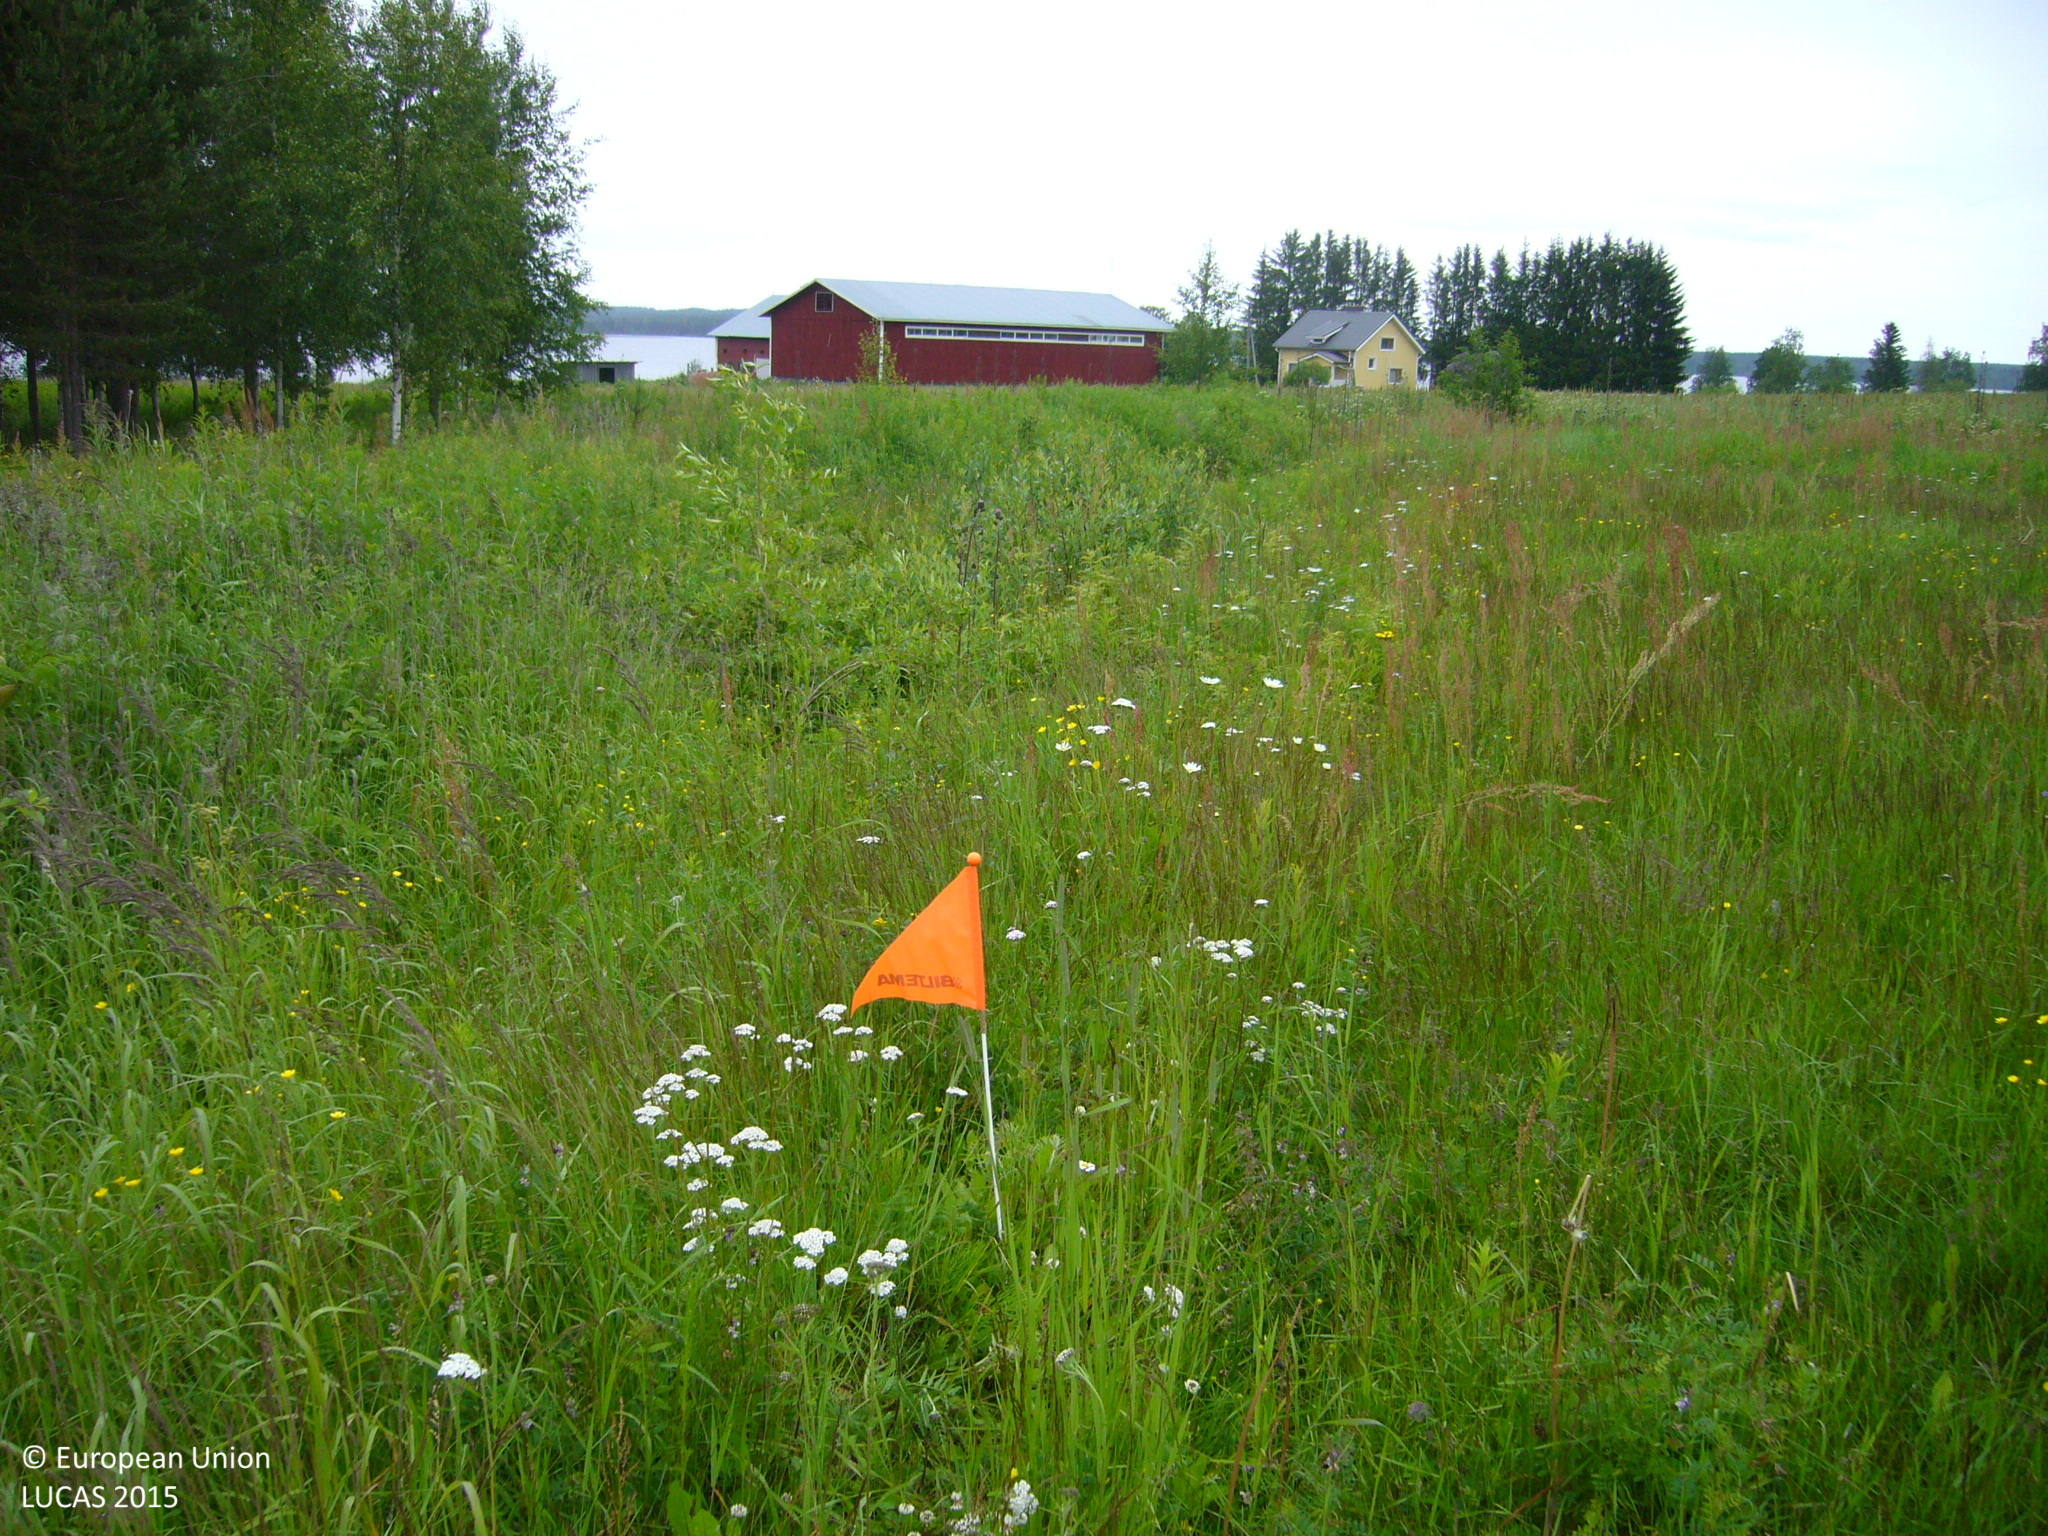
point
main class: Grassland
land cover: Grassland without tree/shrub cover
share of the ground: > 75 %
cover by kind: herbaceous plants 100 %
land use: Agriculture (excluding fallow land and kitchen gardens)
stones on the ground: < 10 %
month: July
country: FI
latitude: 63.4581
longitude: 25.7329
